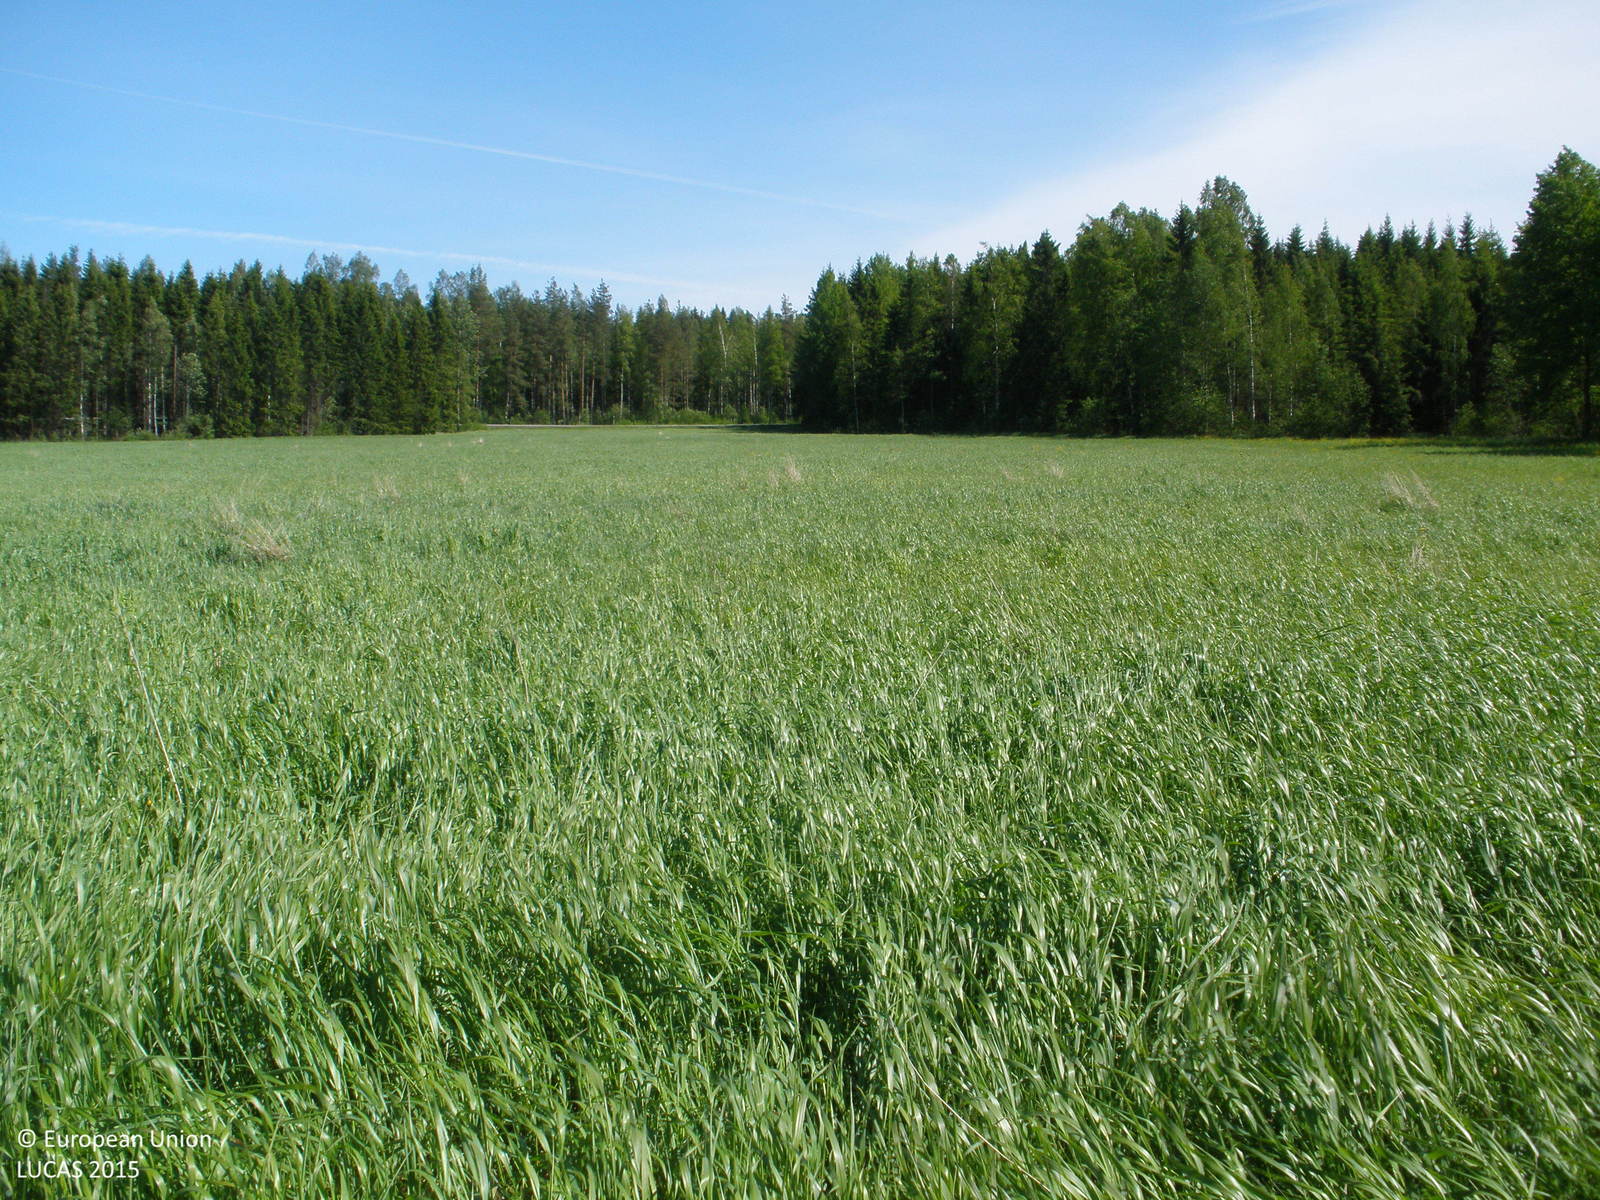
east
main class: Cropland
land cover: Temporary grasslands
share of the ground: > 75 %
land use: Agriculture (excluding fallow land and kitchen gardens)
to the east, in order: Temporary grasslands; Ditches and canals; Pine dominated mixed woodland; Ditches and canals; Paved roads, cycling and walking lanes; Ditches and canals; Spruce dominated mixed woodland
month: June
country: FI
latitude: 60.7300
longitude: 23.5628
